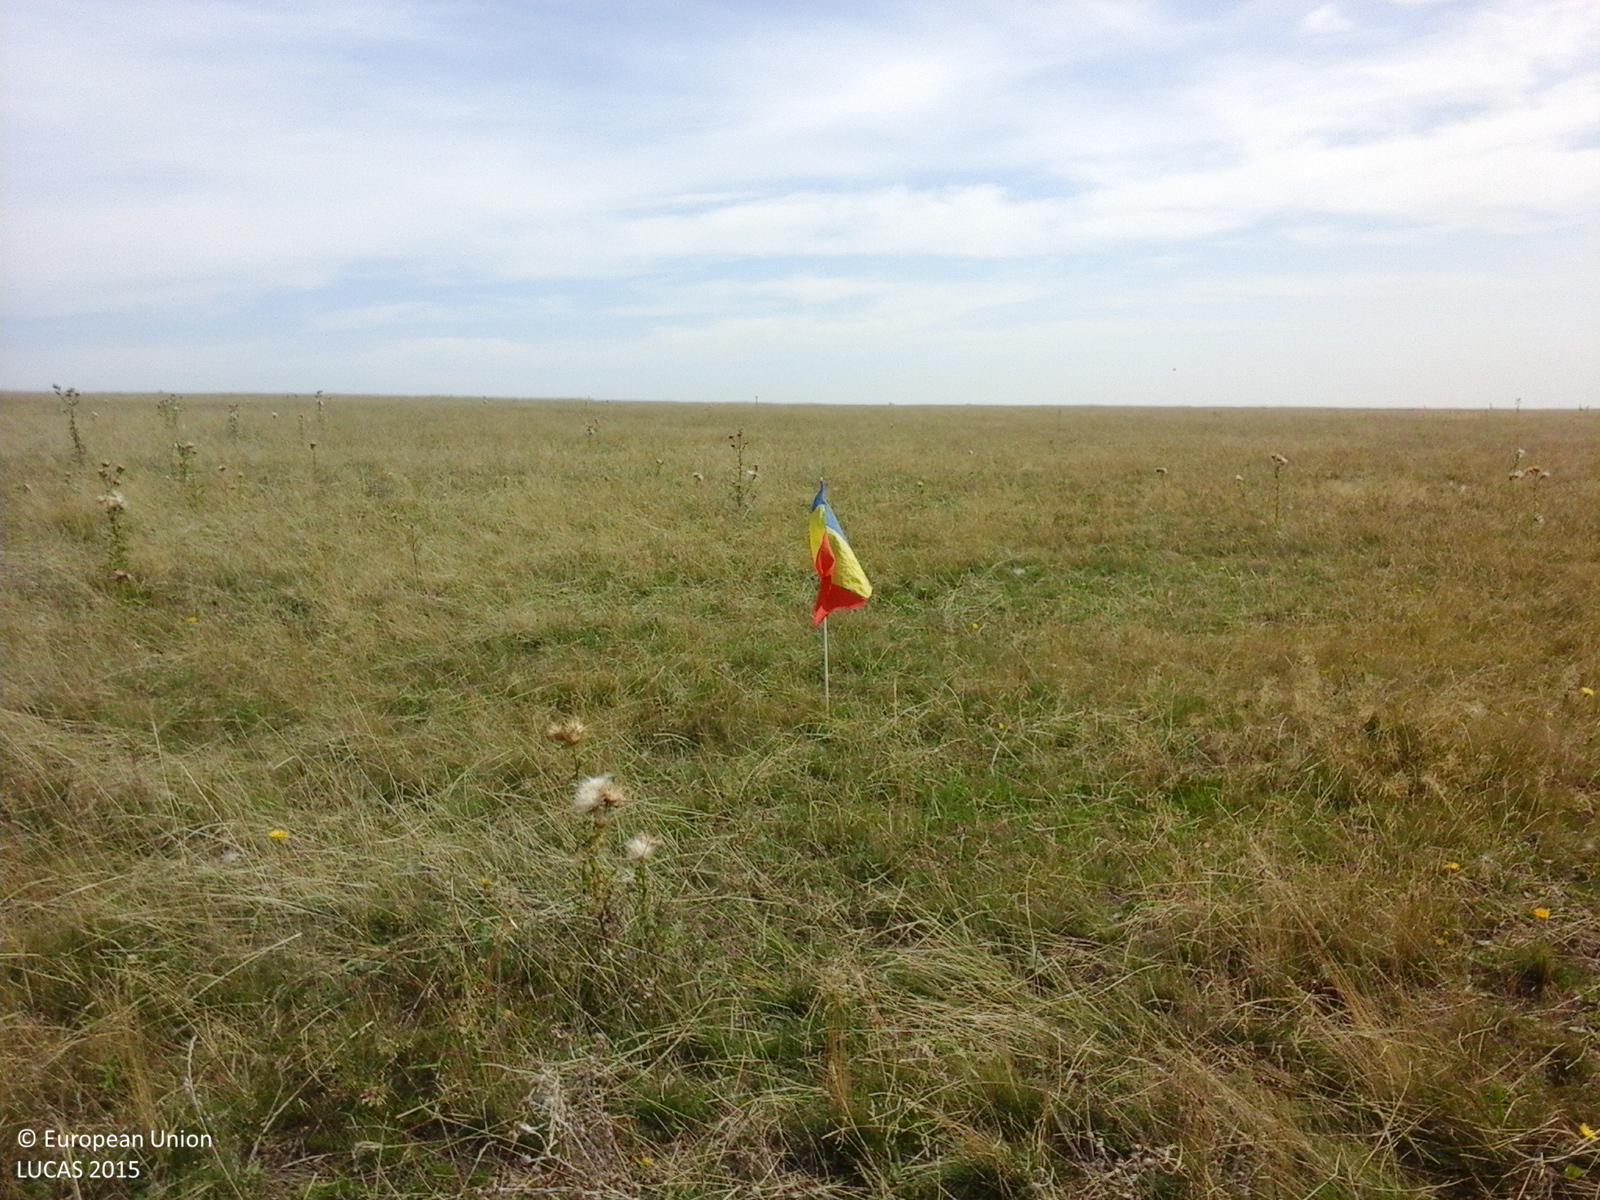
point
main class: Grassland
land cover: Grassland without tree/shrub cover
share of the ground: > 75 %
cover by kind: herbaceous plants 100 %
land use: Agriculture (excluding fallow land and kitchen gardens)
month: September
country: RO
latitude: 46.8156
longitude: 23.5570
